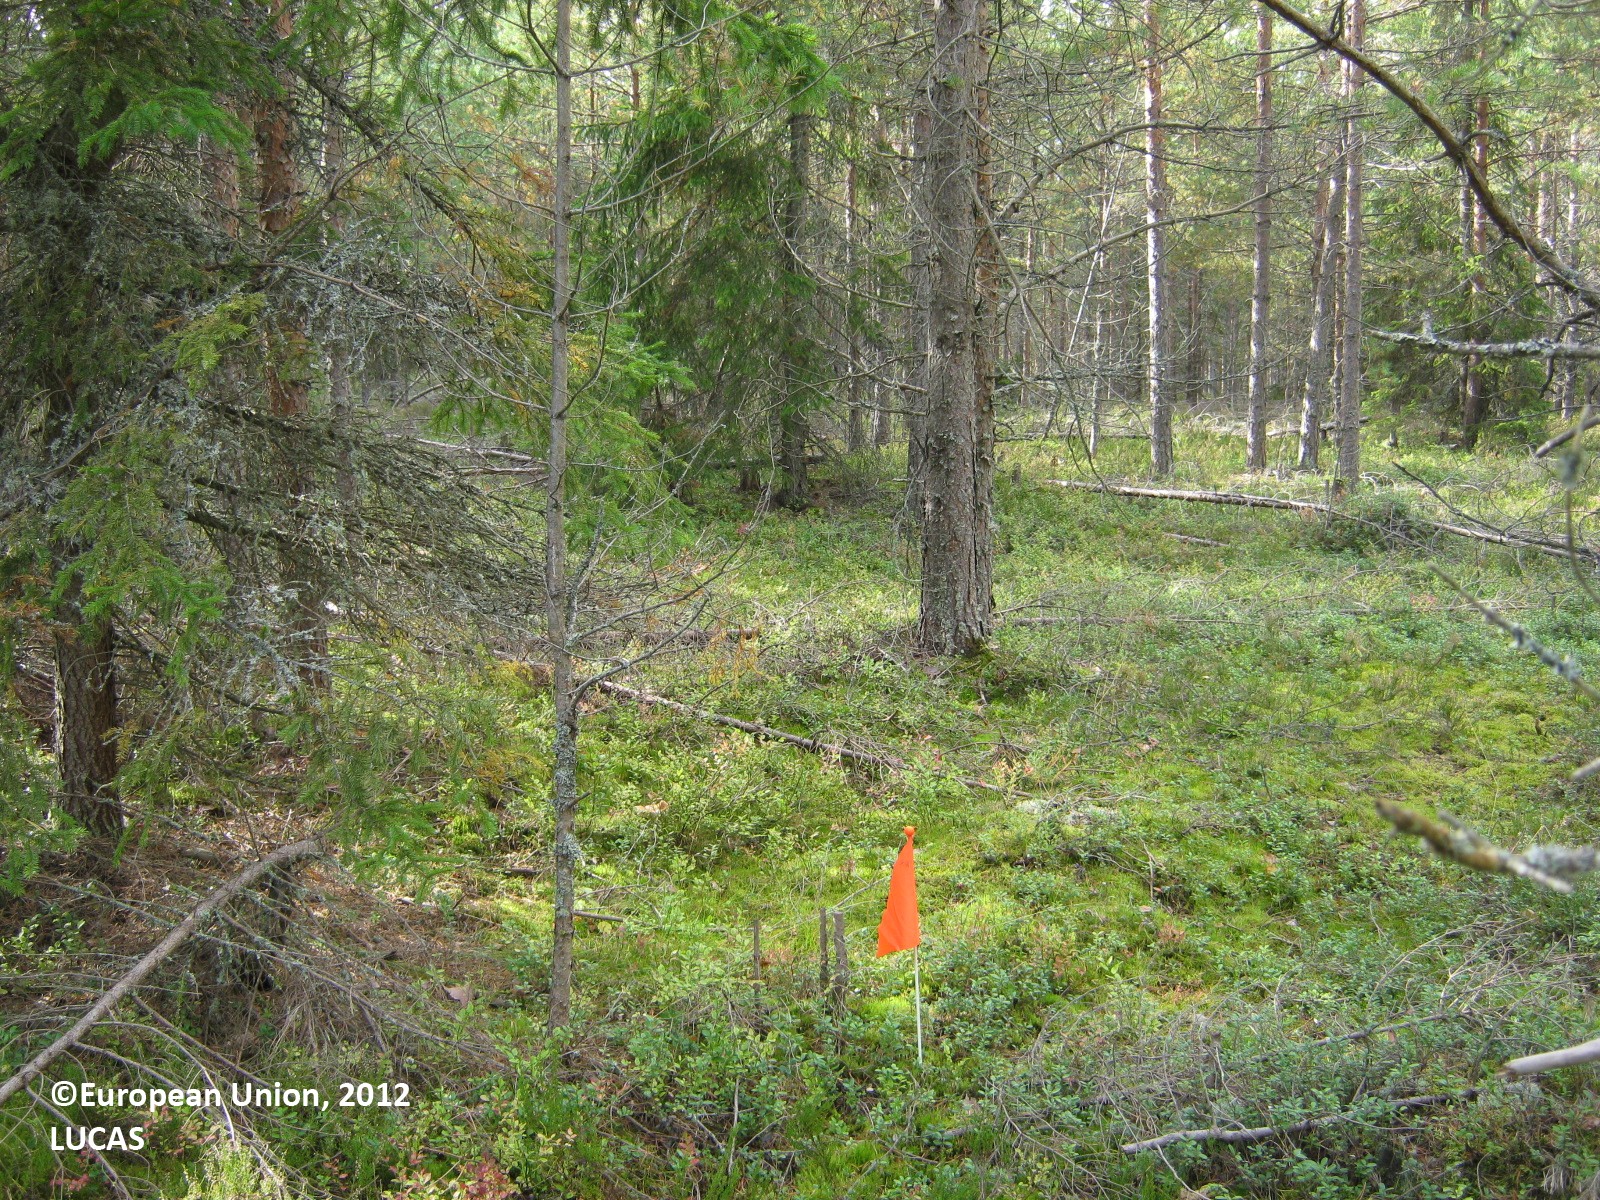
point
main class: Woodland
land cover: Other coniferous woodland
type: boreal forest
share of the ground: 50 - 75 %
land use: Forestry
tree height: > 5 m
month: September
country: FI
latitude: 60.6152
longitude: 27.7518
